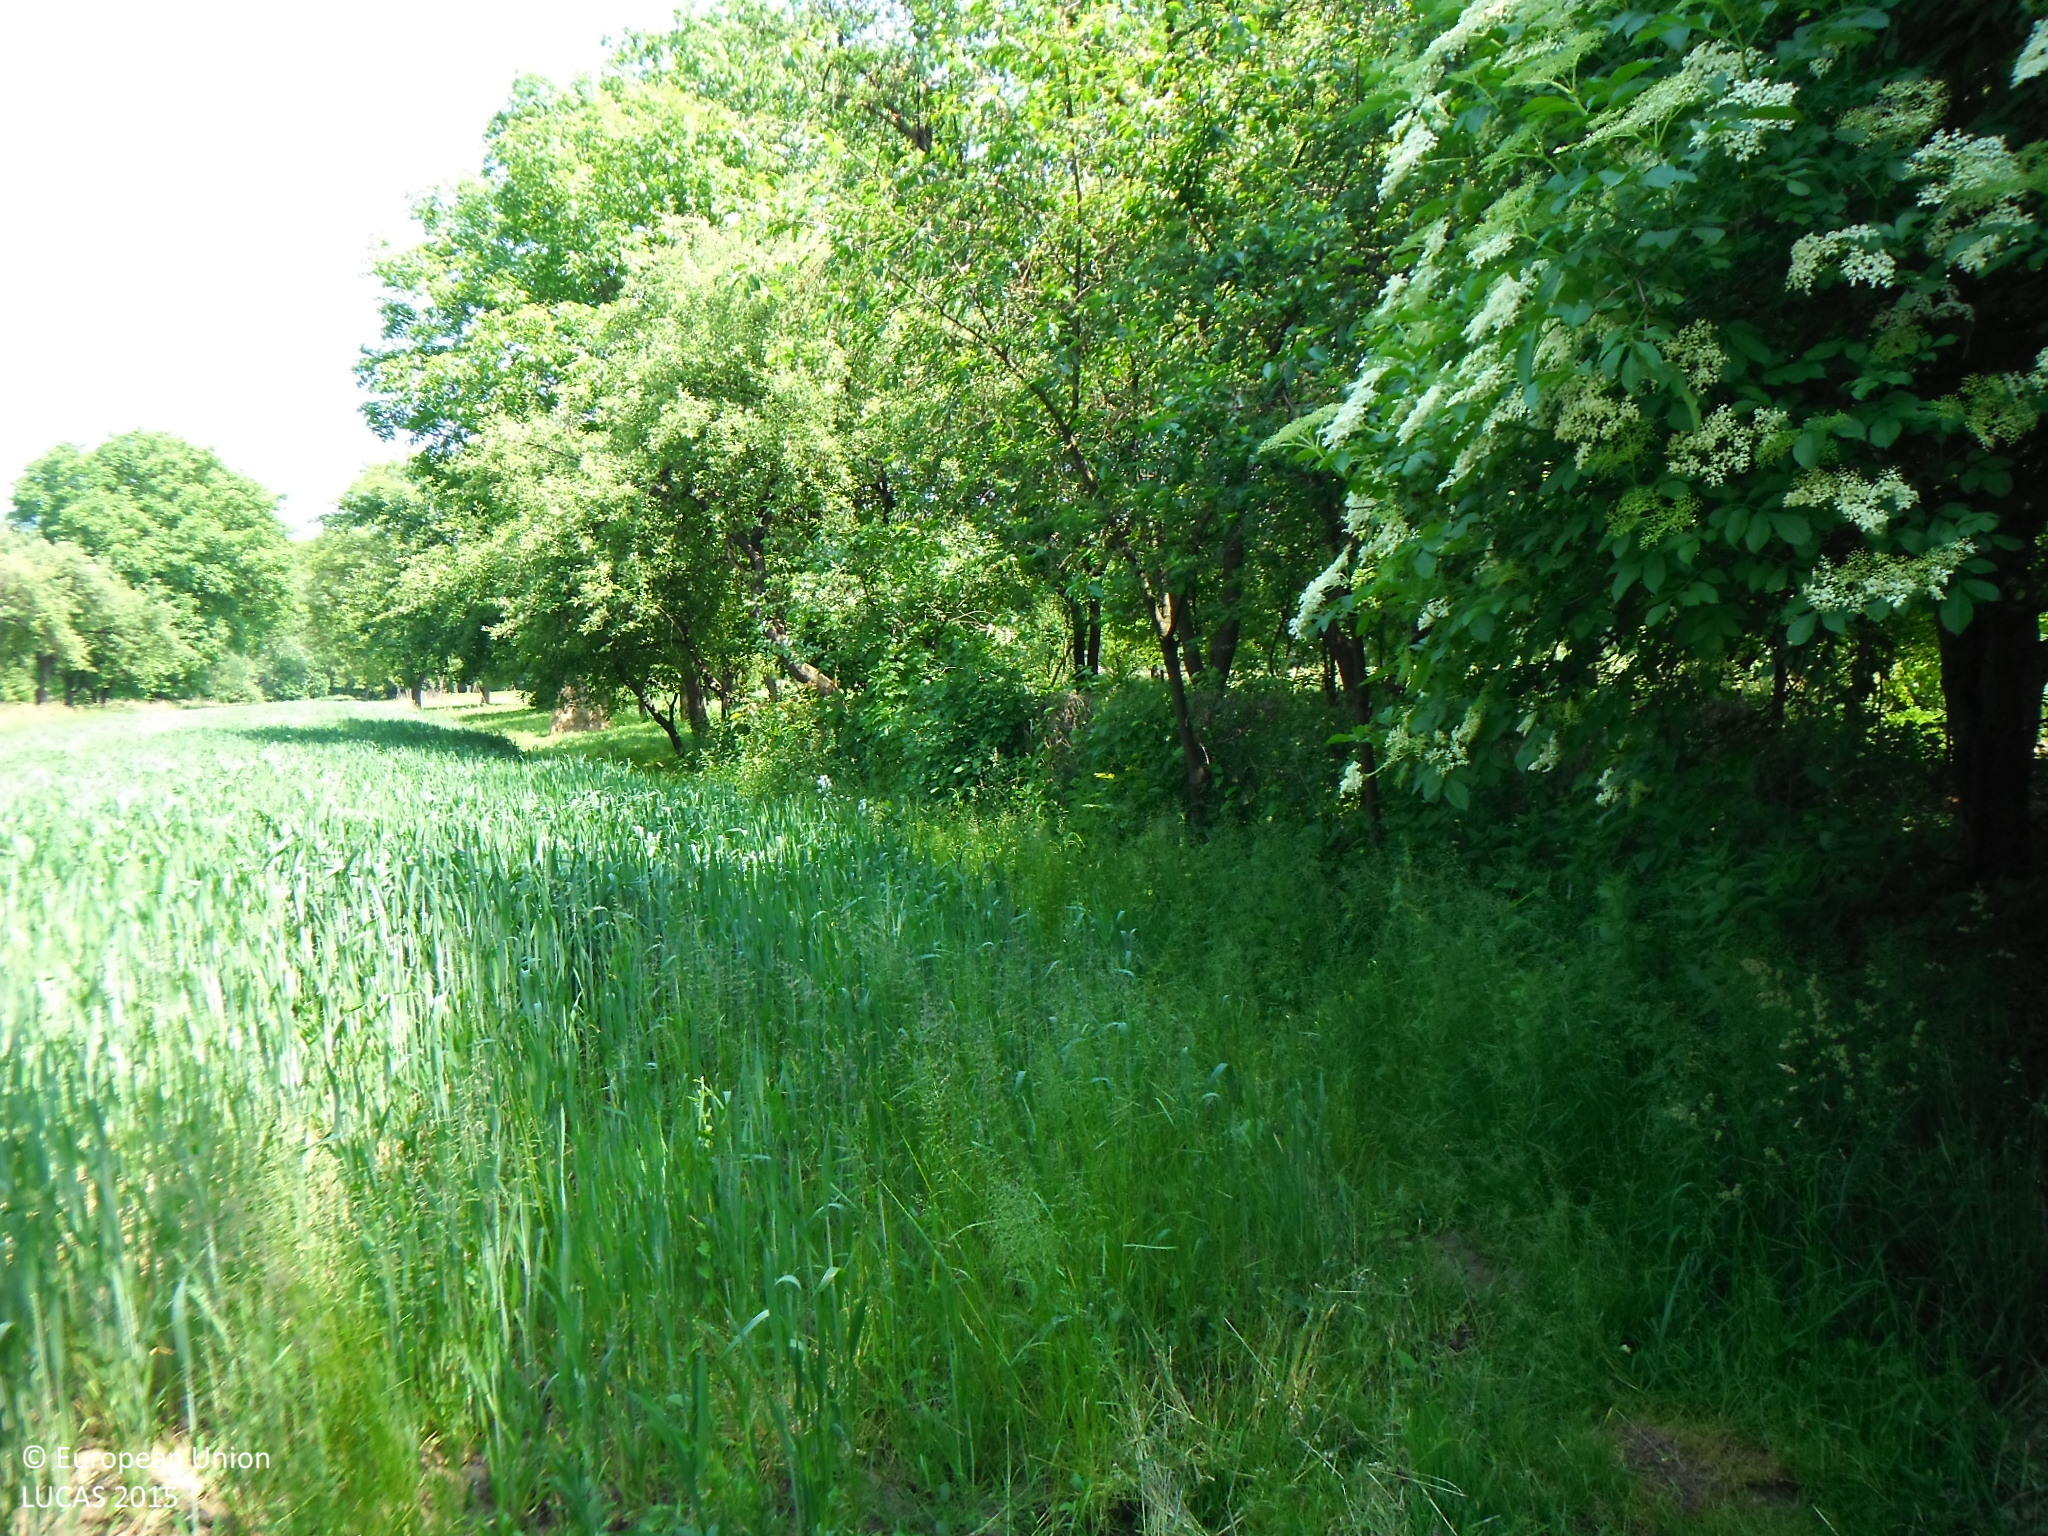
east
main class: Cropland
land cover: Nuts trees
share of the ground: > 75 %
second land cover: Grassland without tree/shrub cover
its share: > 75 %
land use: Kitchen garden
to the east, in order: Nuts trees; Grassland without tree/shrub cover; Artificial constructions in urban areas; Grassland with sparse tree/shrub cover; Common wheat; Grassland without tree/shrub cover; Spontaneously vegetated surfaces; Grassland without tree/shrub cover; Common wheat; Other fibre and oleaginous crops; Grassland without tree/shrub cover; Mixed cereals for fodder
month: June
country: SK
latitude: 48.9932
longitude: 21.5707
